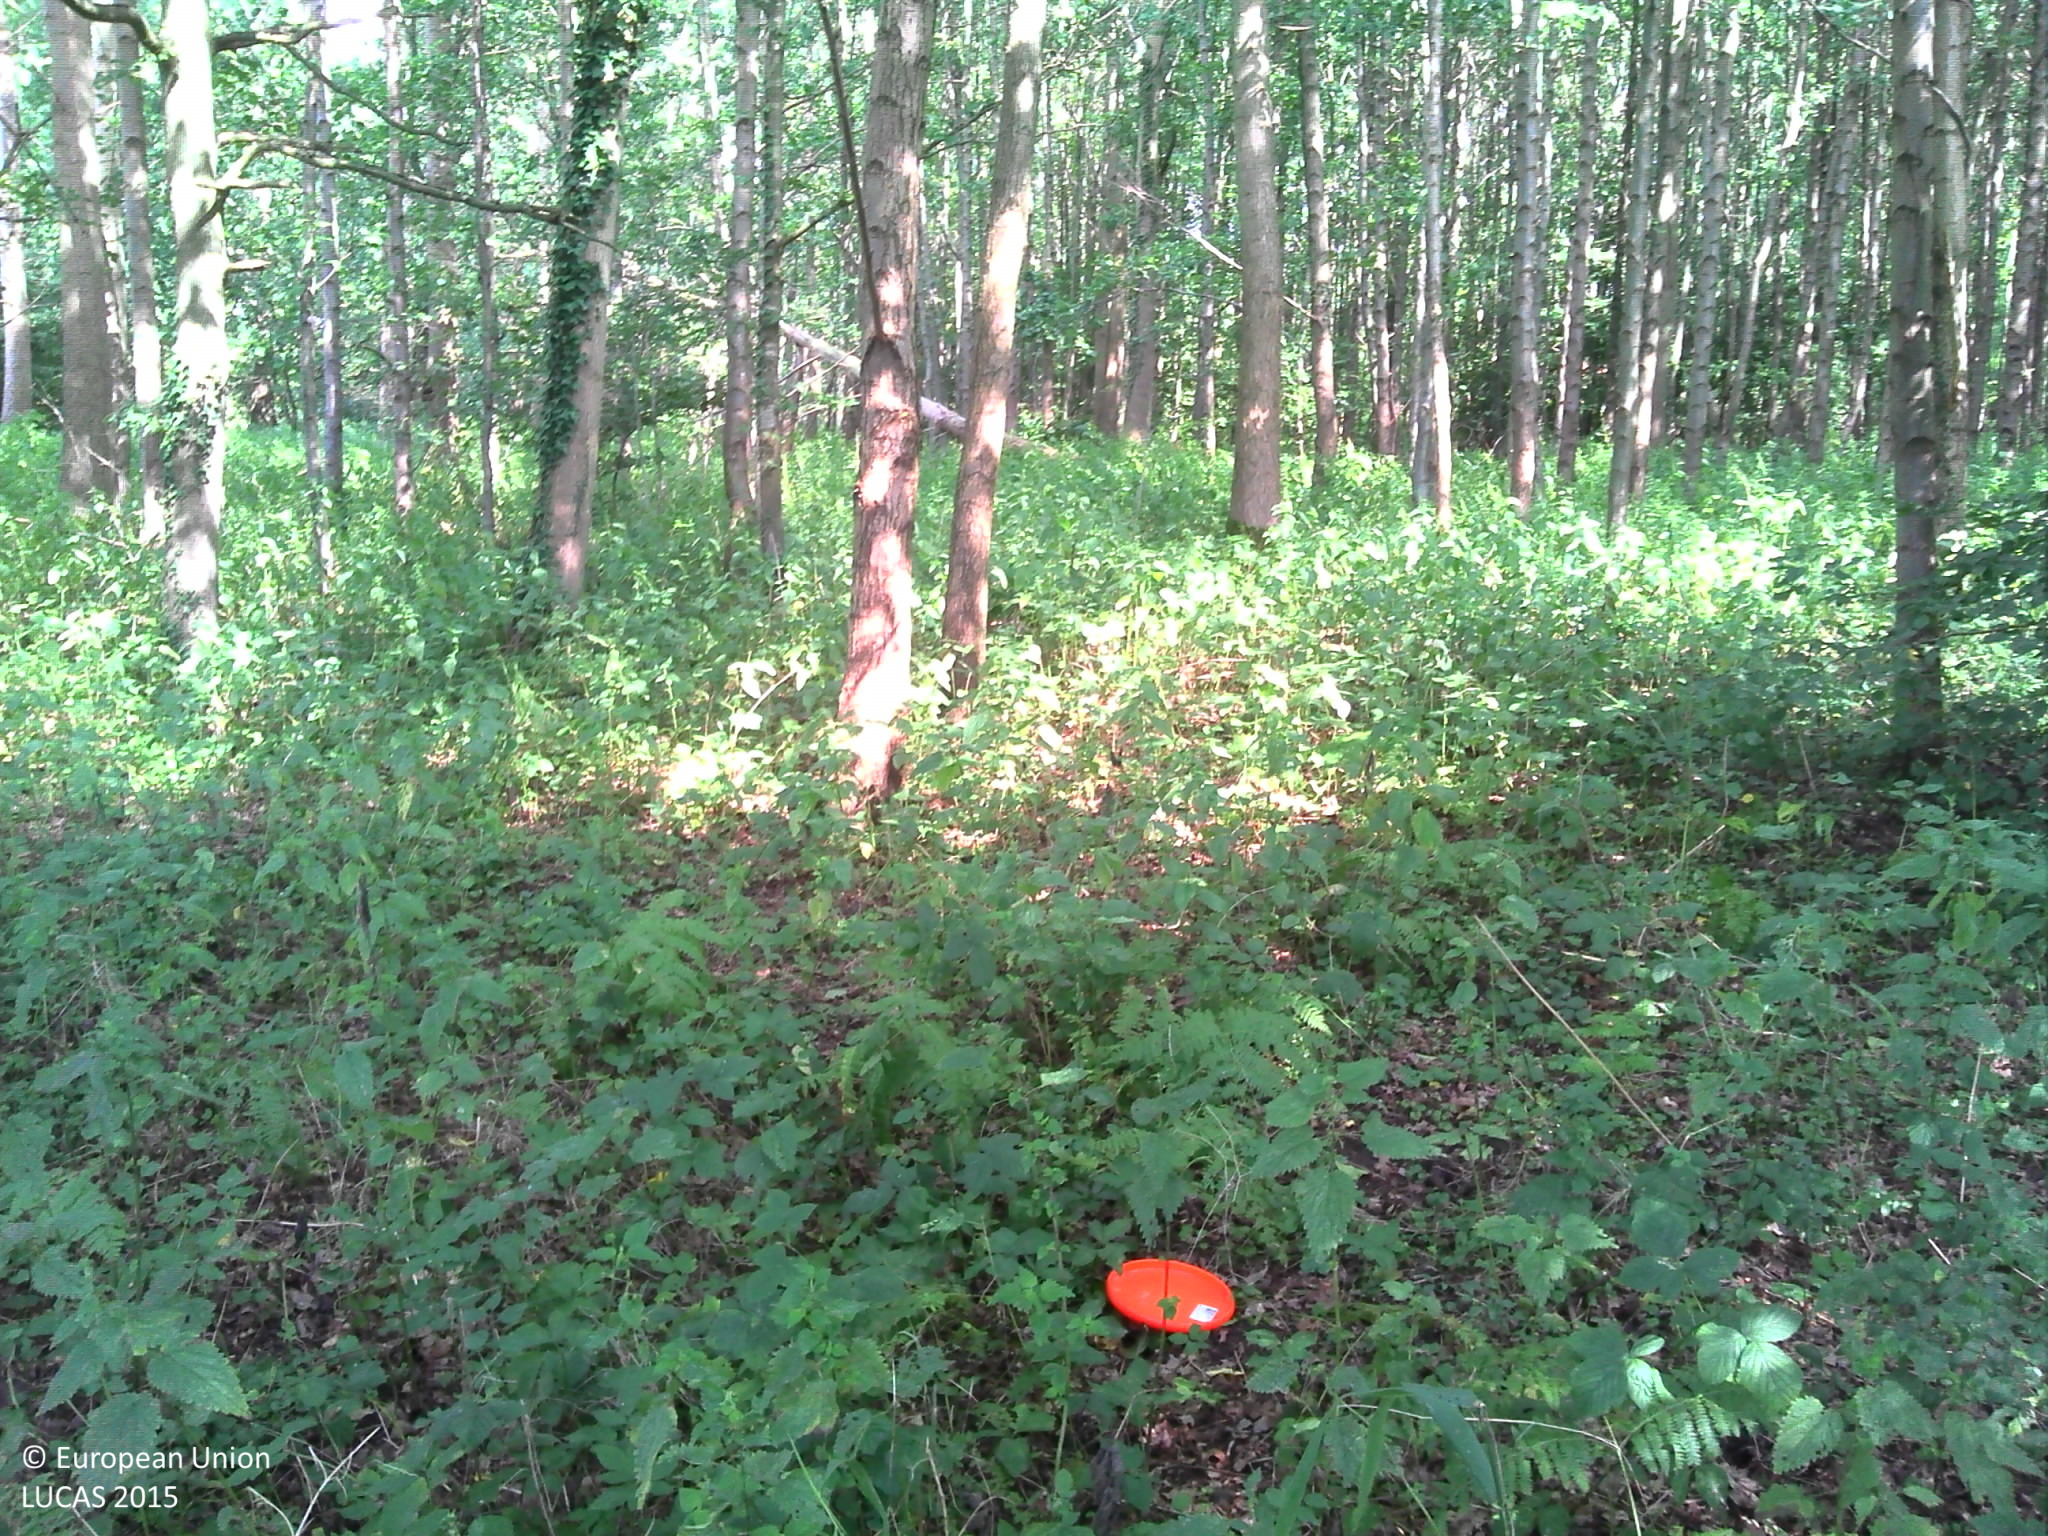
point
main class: Woodland
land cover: Broadleaved woodland
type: floodplain forest
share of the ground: > 75 %
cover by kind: broadleaved forest trees 90 %, herbaceous plants 10 %
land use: Forestry
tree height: > 5 m
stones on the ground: < 10 %
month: August
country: BE
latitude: 51.1427
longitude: 5.1232
